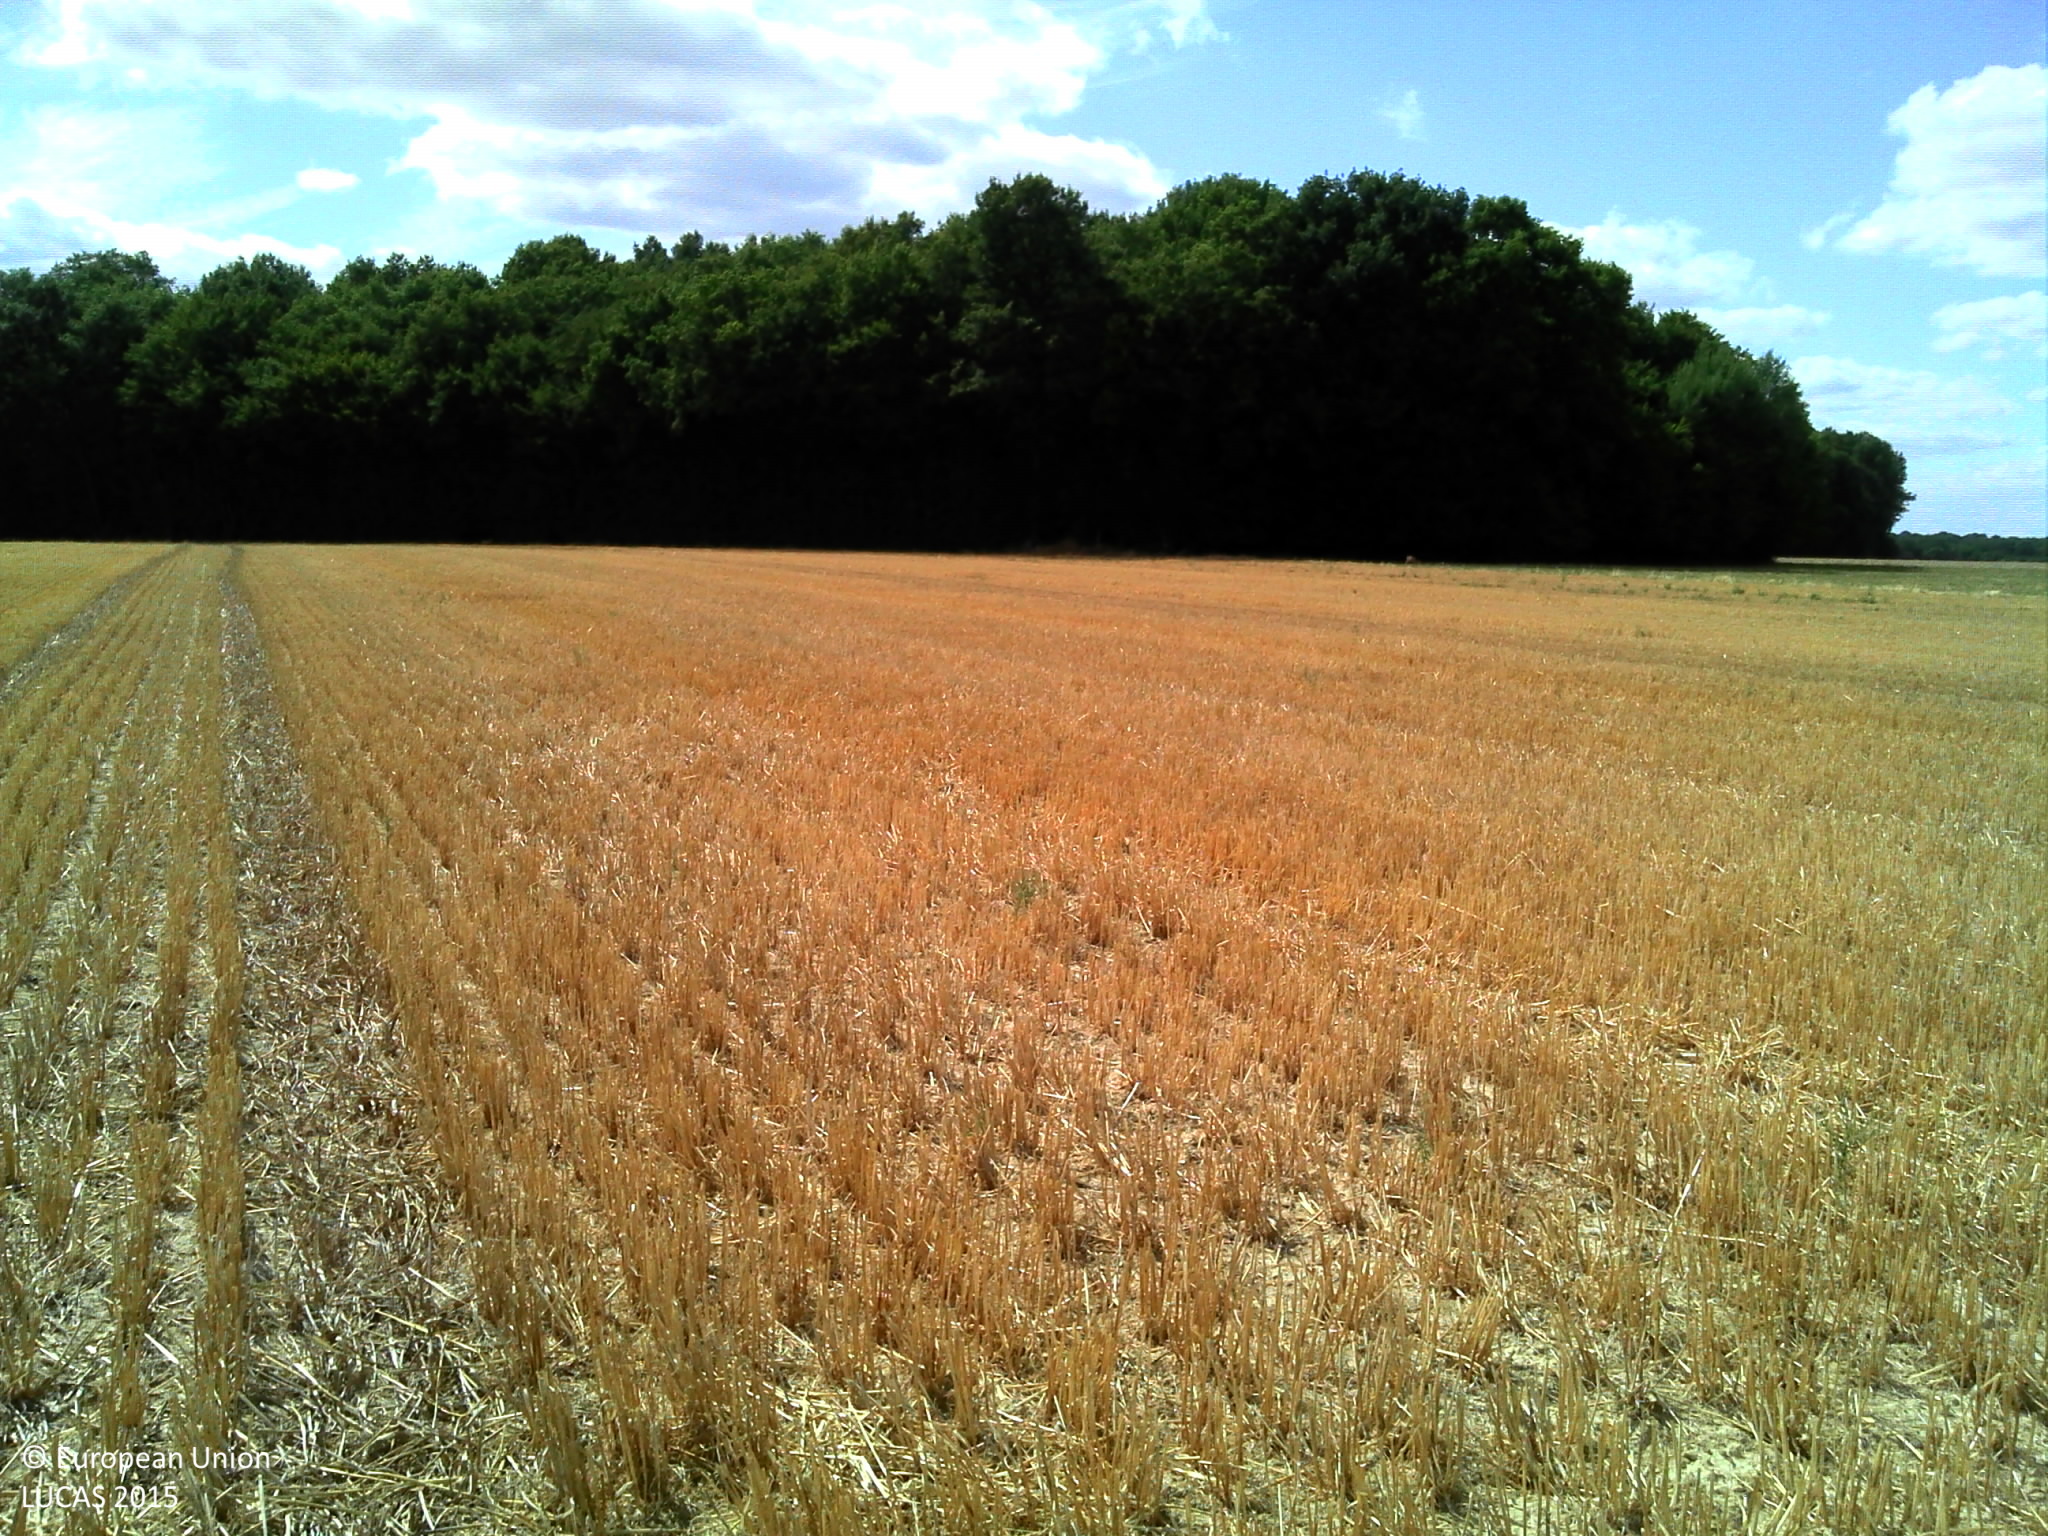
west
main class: Cropland
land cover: Barley
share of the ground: > 75 %
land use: Agriculture (excluding fallow land and kitchen gardens)
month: July
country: FR
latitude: 47.8063
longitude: 3.0636
